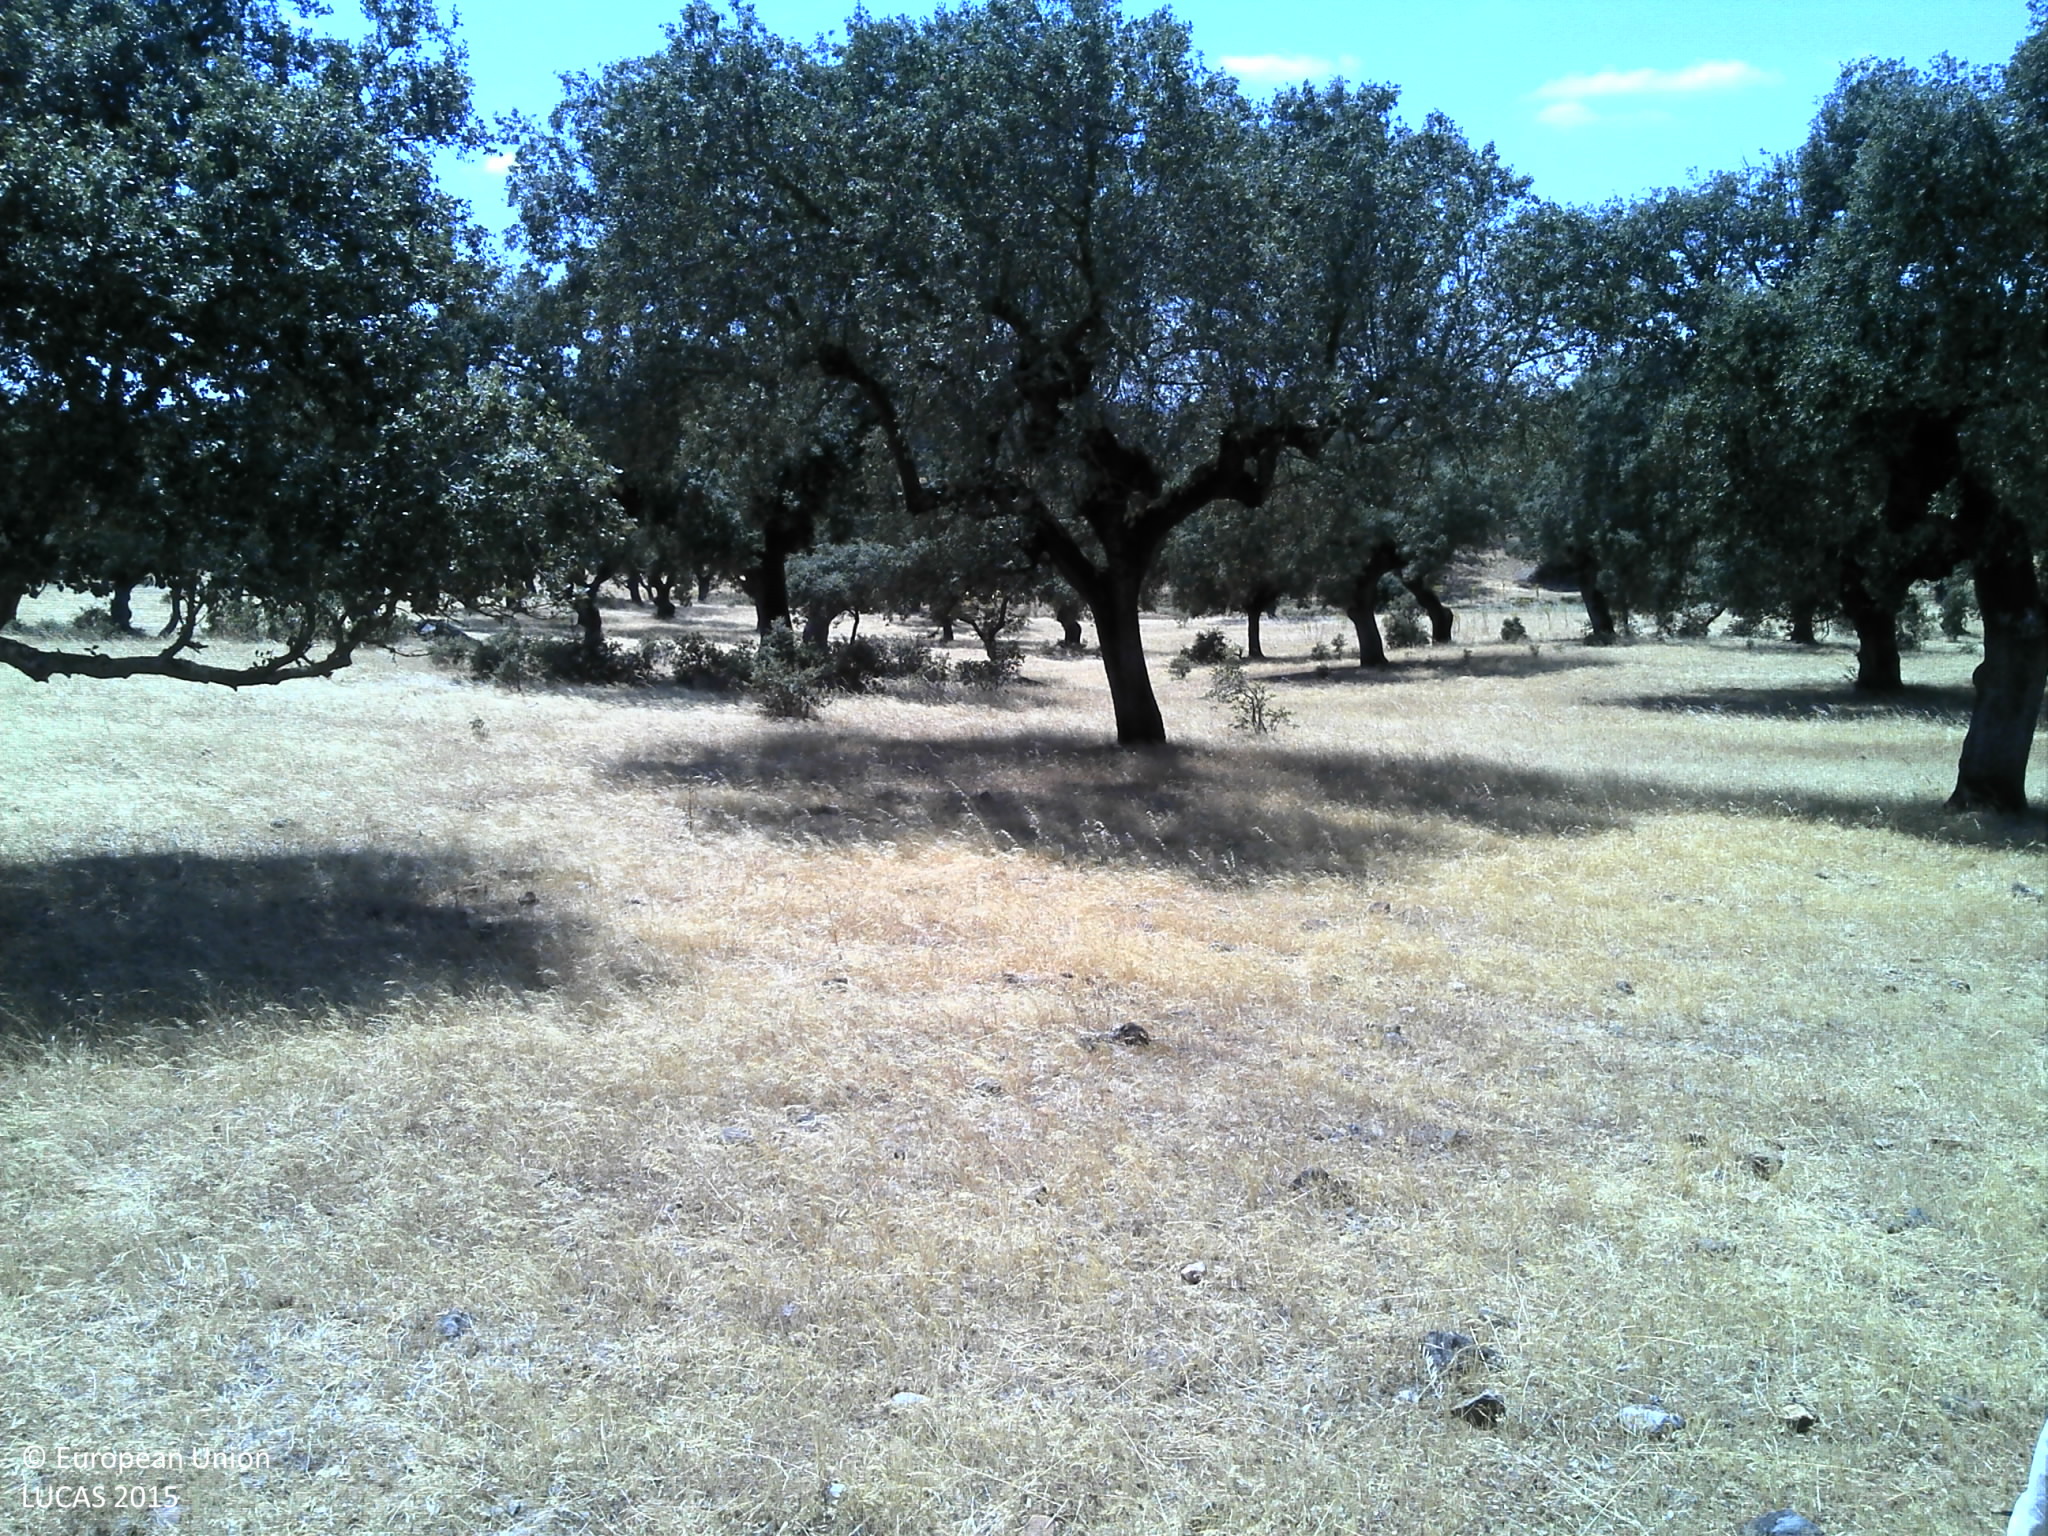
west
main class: Woodland
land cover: Broadleaved woodland
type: broadleaved evergreen forest
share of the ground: 25 - 50 %
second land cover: Grassland without tree/shrub cover
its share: 50 - 75 %
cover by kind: herbaceous plants 65 %, broadleaved forest trees 25 %, unconsolidated bare surface 10 %
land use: Forestry
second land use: Agriculture (excluding fallow land and kitchen gardens)
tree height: > 5 m
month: July
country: PT
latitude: 38.8204
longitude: -7.3418
